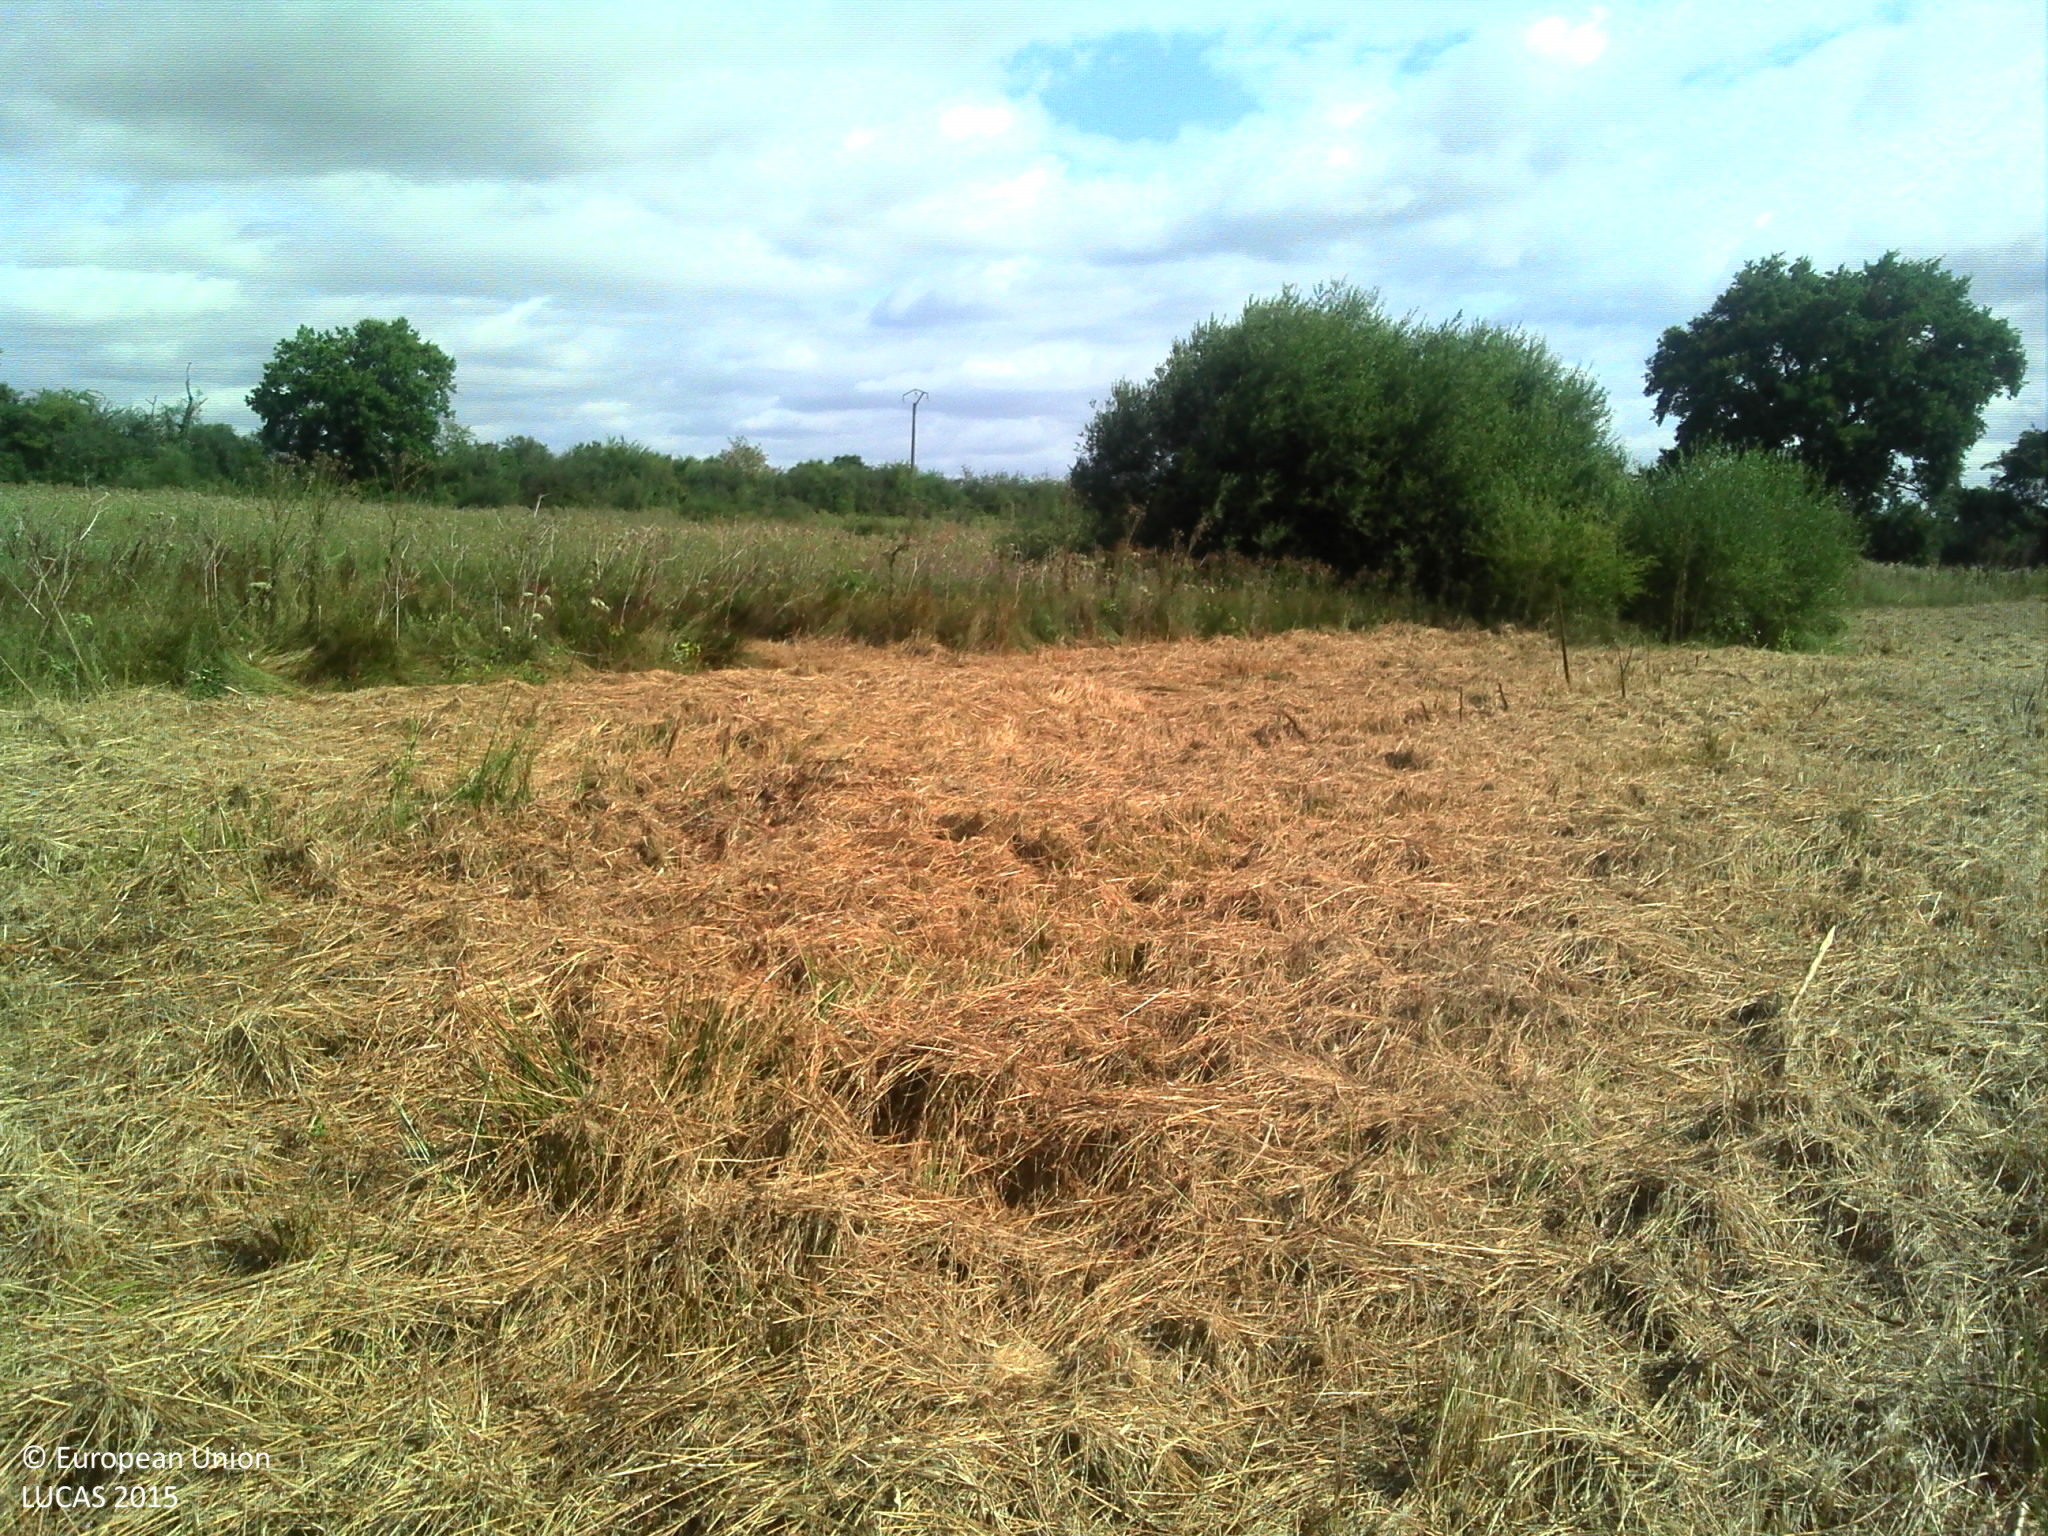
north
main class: Grassland
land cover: Grassland without tree/shrub cover
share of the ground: > 75 %
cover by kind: herbaceous plants 100 %
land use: Agriculture (excluding fallow land and kitchen gardens)
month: July
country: FR
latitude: 46.2780
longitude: 1.2028
